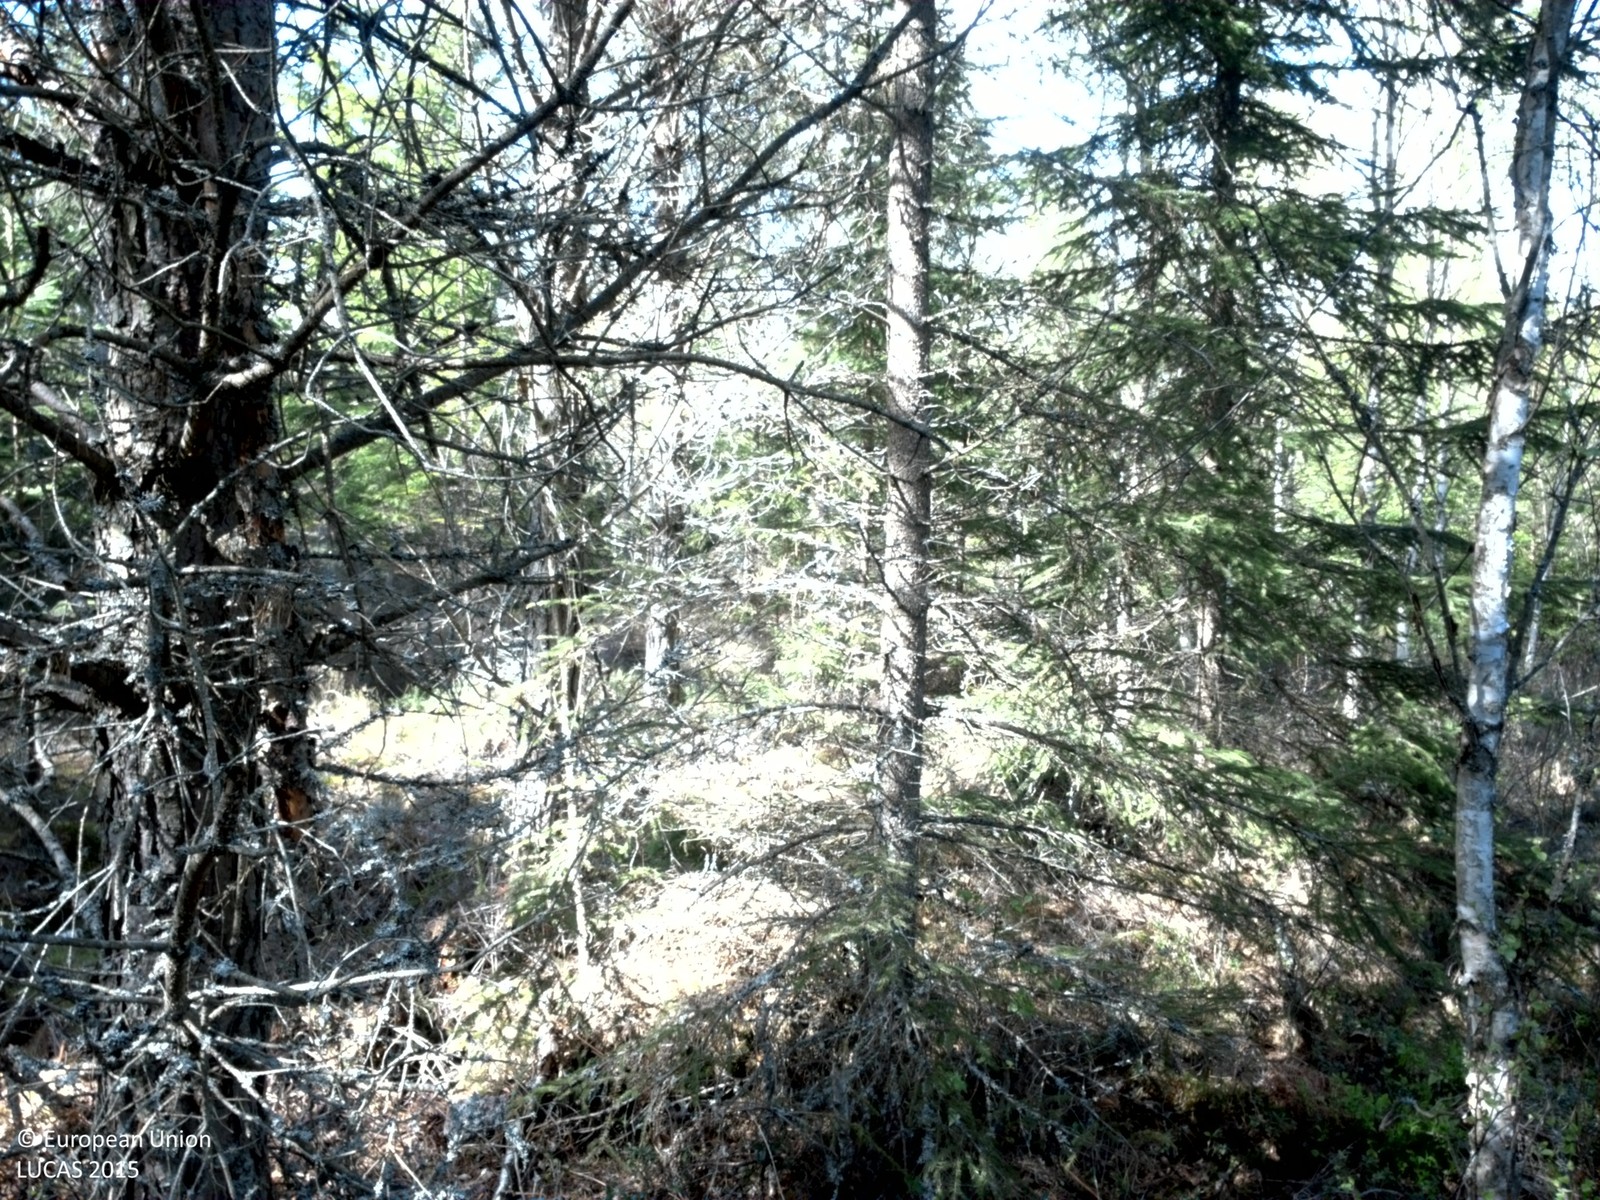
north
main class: Woodland
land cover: Pine dominated coniferous woodland
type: boreal forest
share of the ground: > 75 %
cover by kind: coniferous forest trees 80 %, broadleaved forest trees 10 %, lichens and mosses 10 %
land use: Forestry
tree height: > 5 m
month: May
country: SE
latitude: 56.7652
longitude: 15.2495
